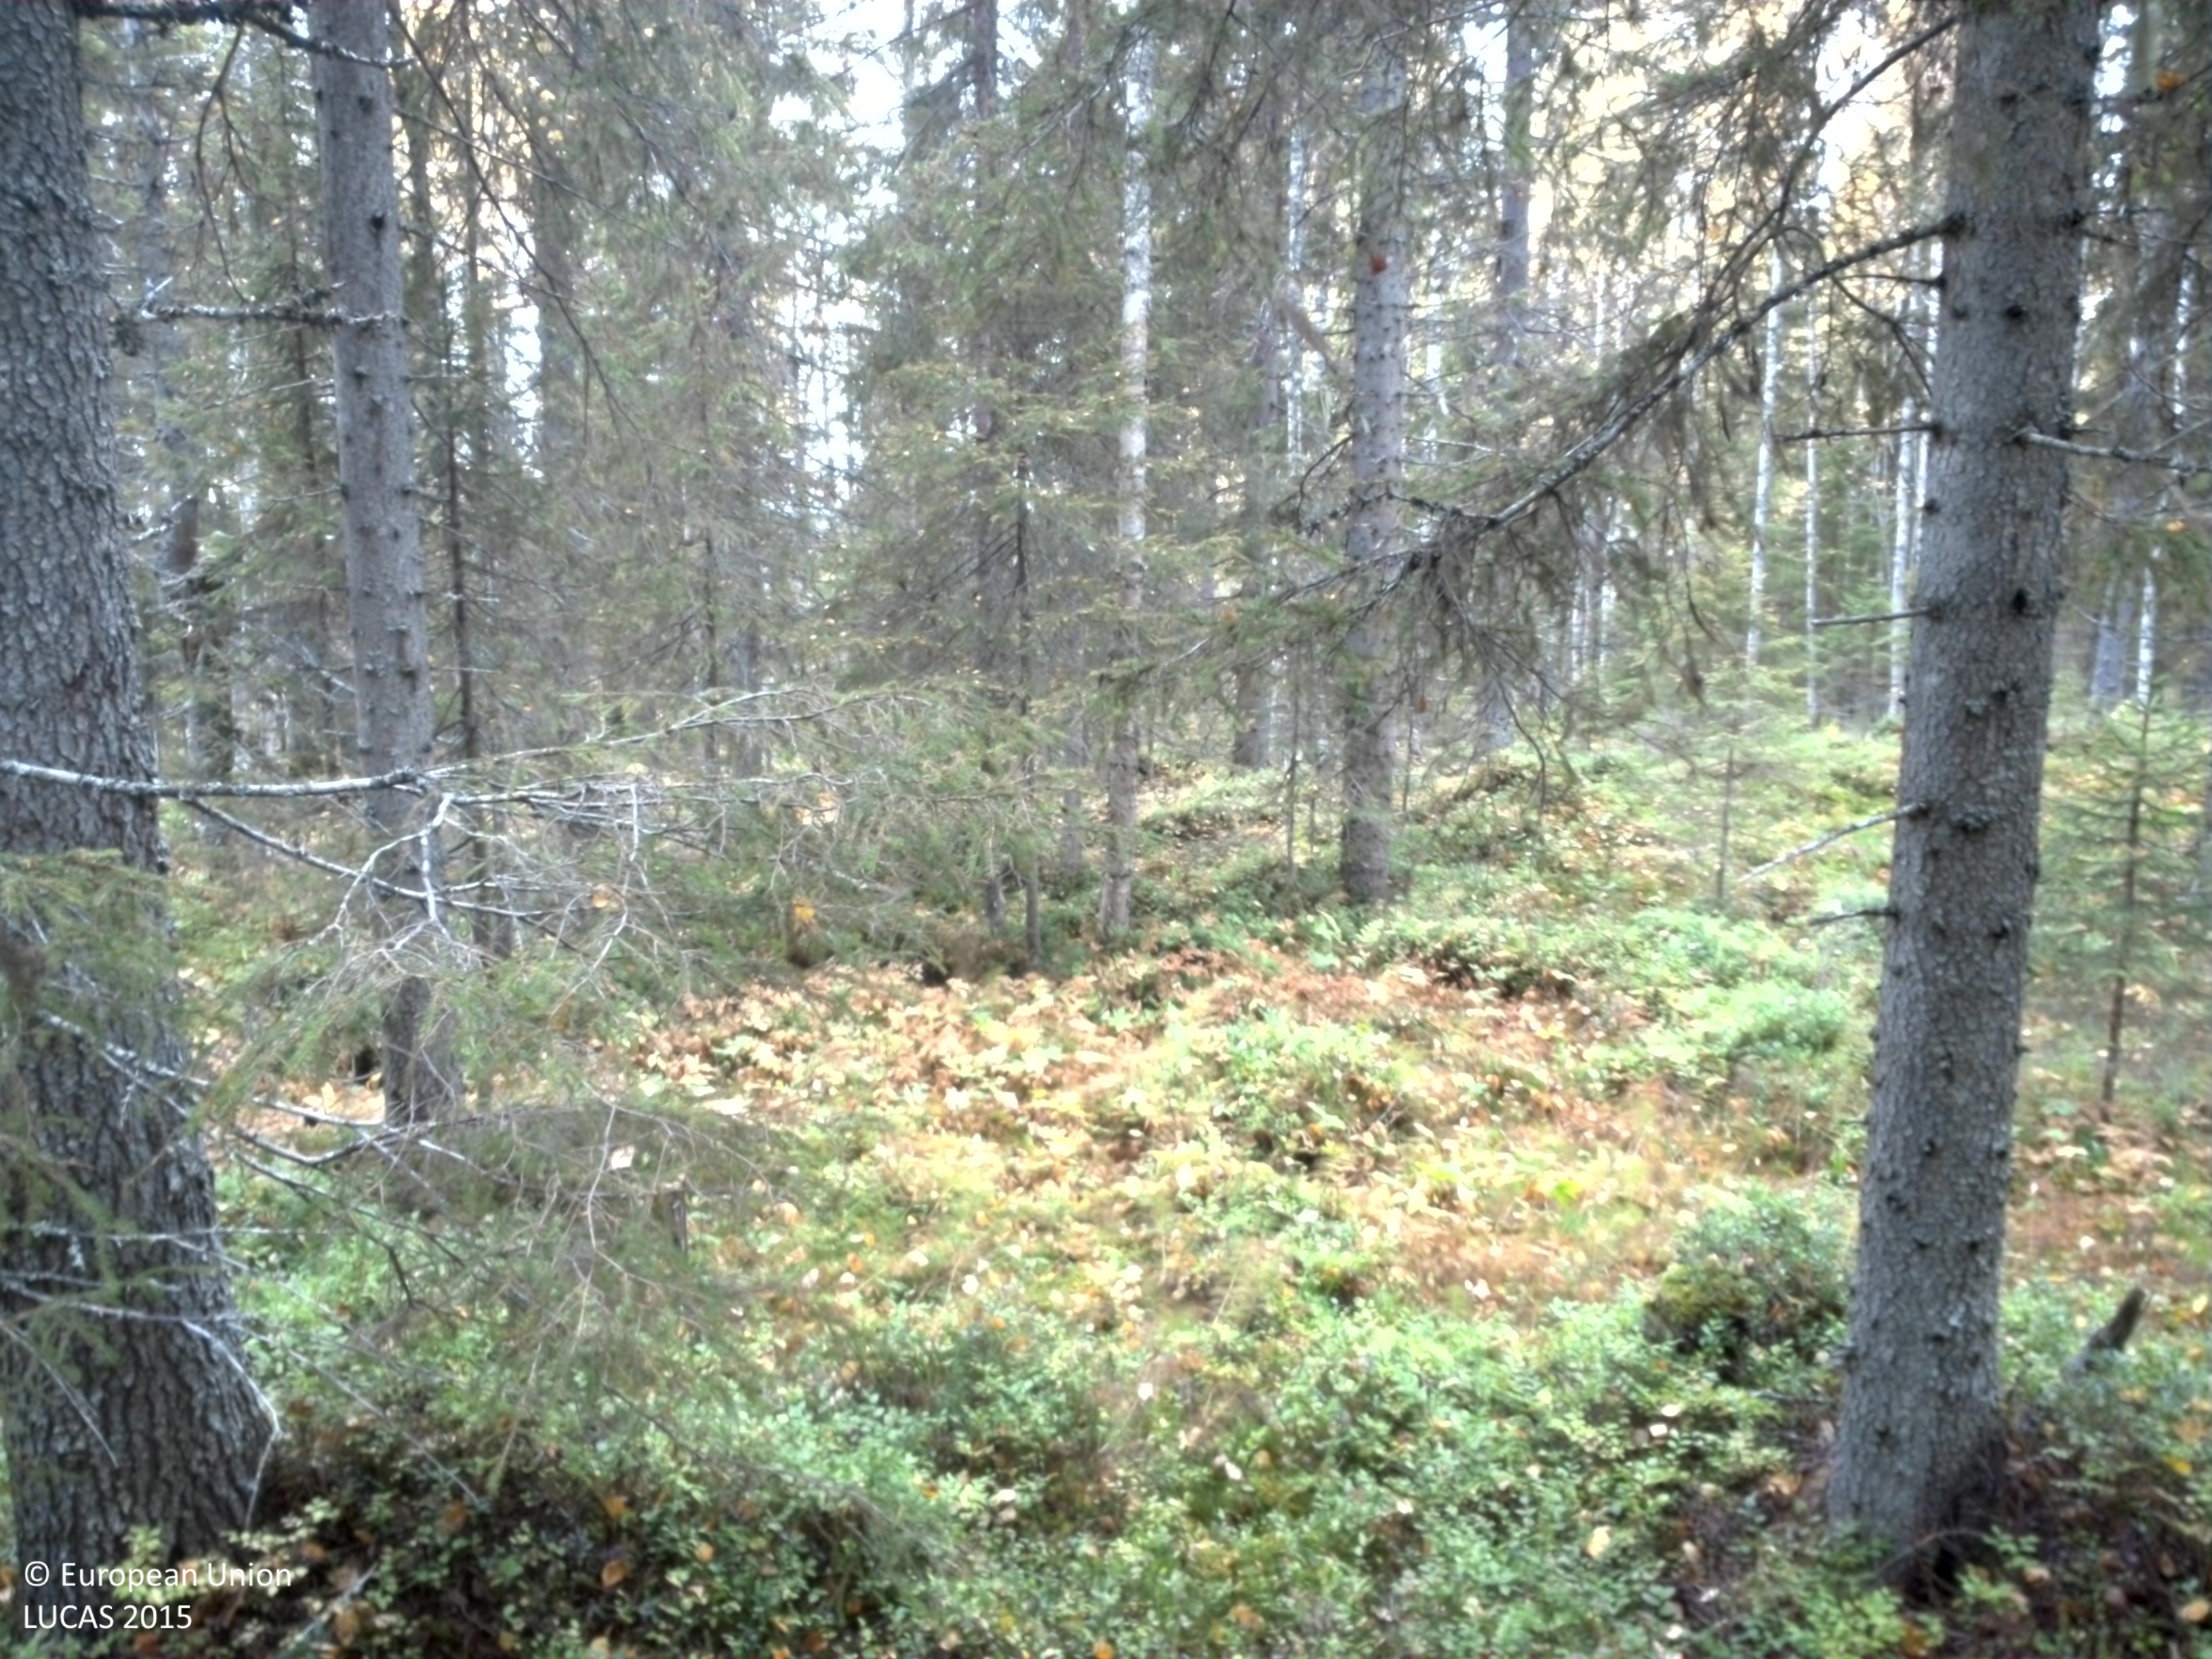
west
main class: Woodland
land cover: Spruce dominated mixed woodland
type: boreal forest
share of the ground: 50 - 75 %
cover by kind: coniferous forest trees 35 %, shrubs 20 %, herbaceous plants 20 %, broadleaved forest trees 15 %, lichens and mosses 10 %
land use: Forestry
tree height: > 5 m
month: September
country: SE
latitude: 65.1215
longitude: 17.6532
